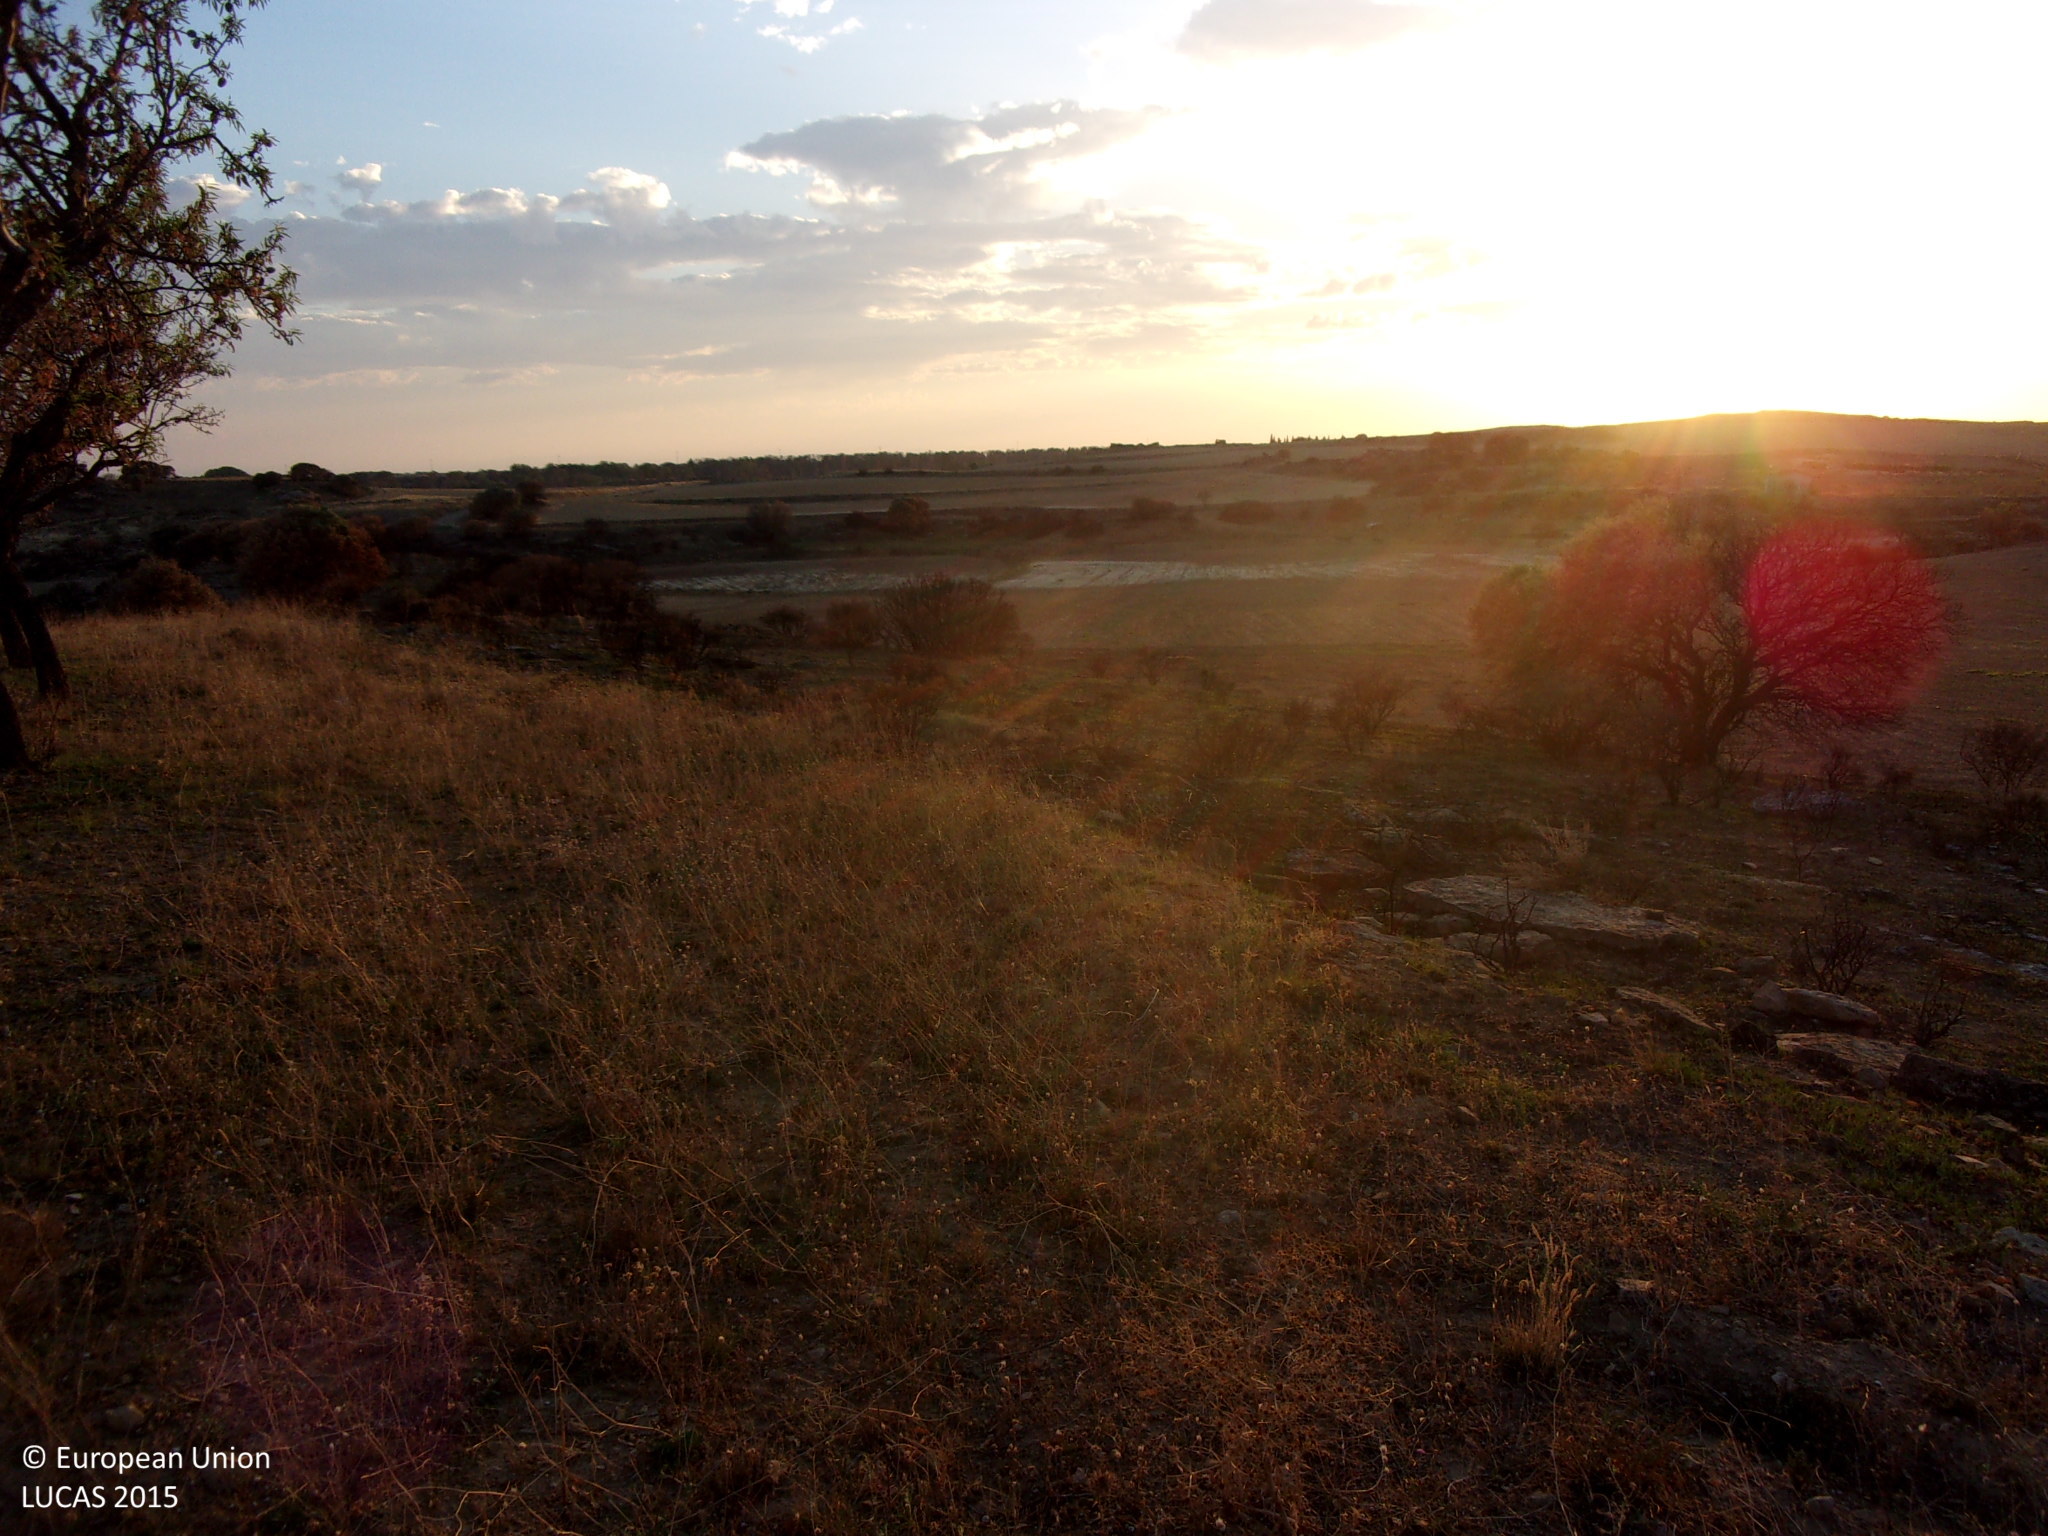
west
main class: Cropland
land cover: Nuts trees
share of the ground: 10 - 25 %
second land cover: Spontaneously vegetated surfaces
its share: > 75 %
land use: Agriculture (excluding fallow land and kitchen gardens)
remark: Burnt area
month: August
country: ES
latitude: 42.2529
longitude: -1.1687
